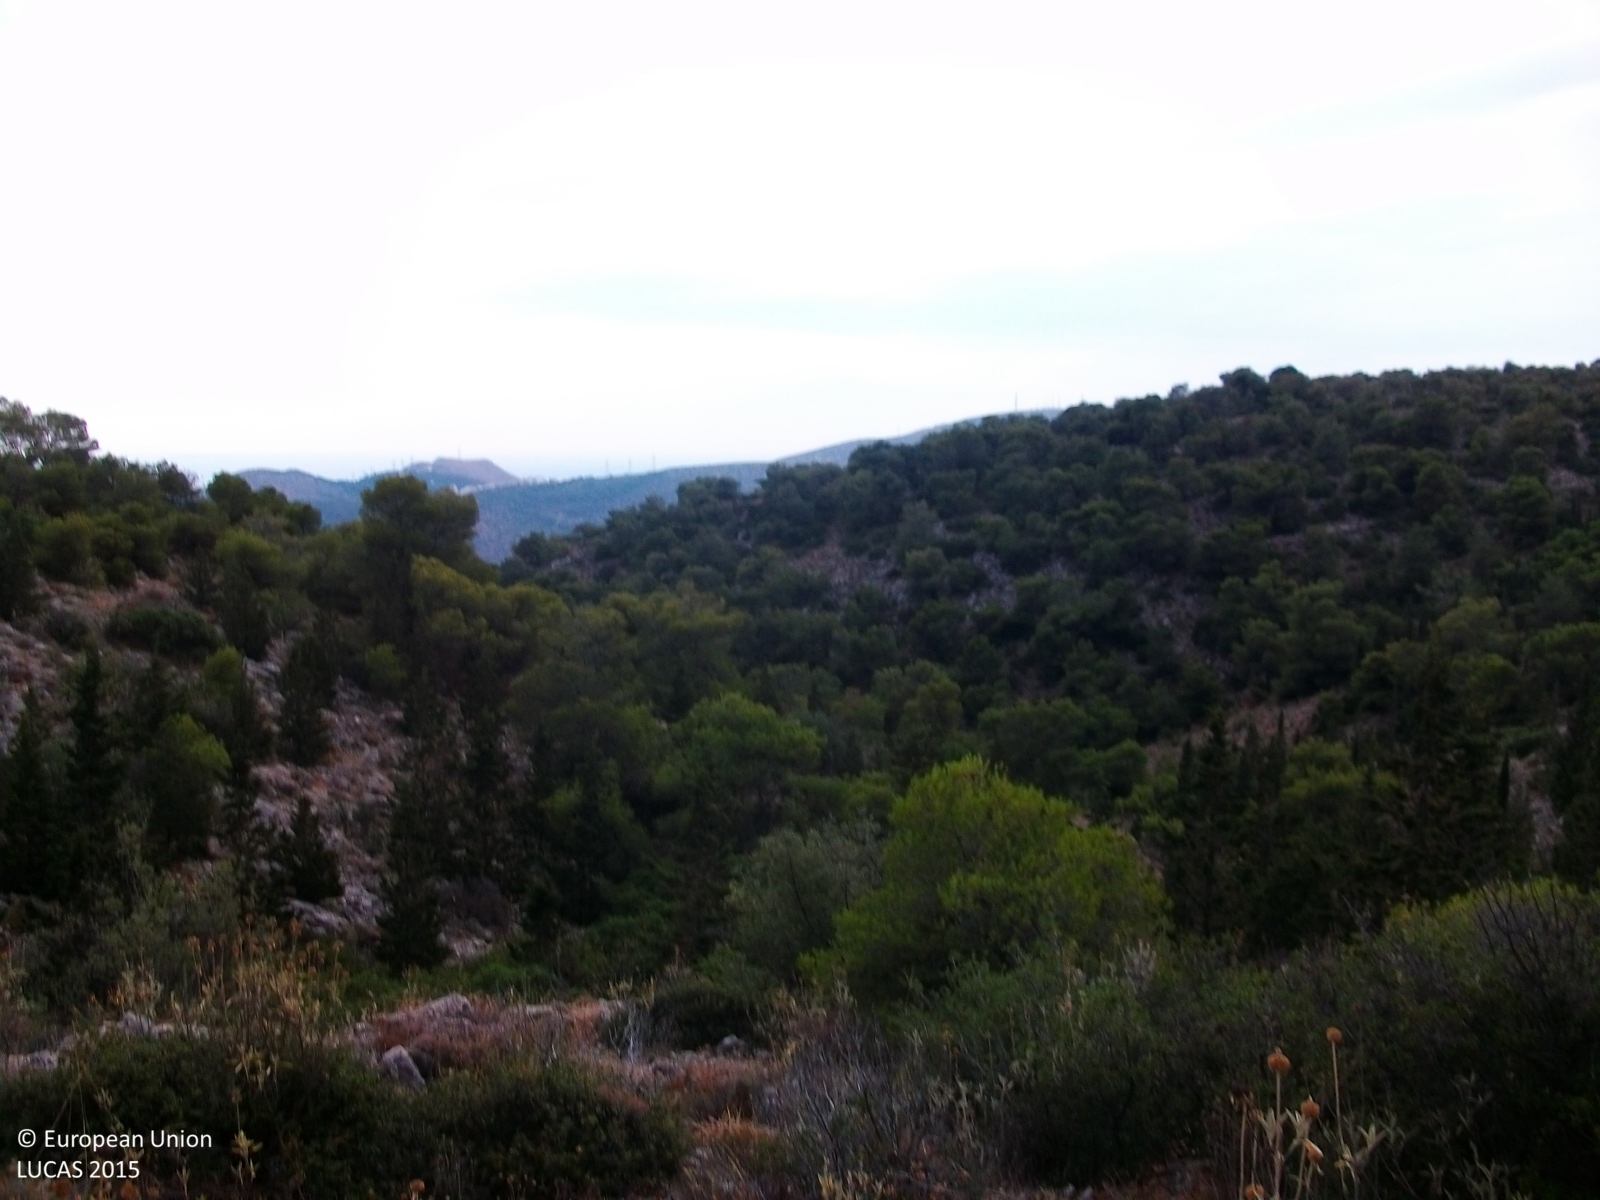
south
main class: Woodland
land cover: Pine dominated coniferous woodland
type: coniferous forest of the mediterranean region
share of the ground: 10 - 25 %
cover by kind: shrubs 30 %, herbaceous plants 30 %, coniferous forest trees 20 %, consolidated bare surface 20 %
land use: Semi-natural and natural areas not in use
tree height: < 5 m
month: June
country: GR
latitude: 38.0264
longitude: 23.6393
